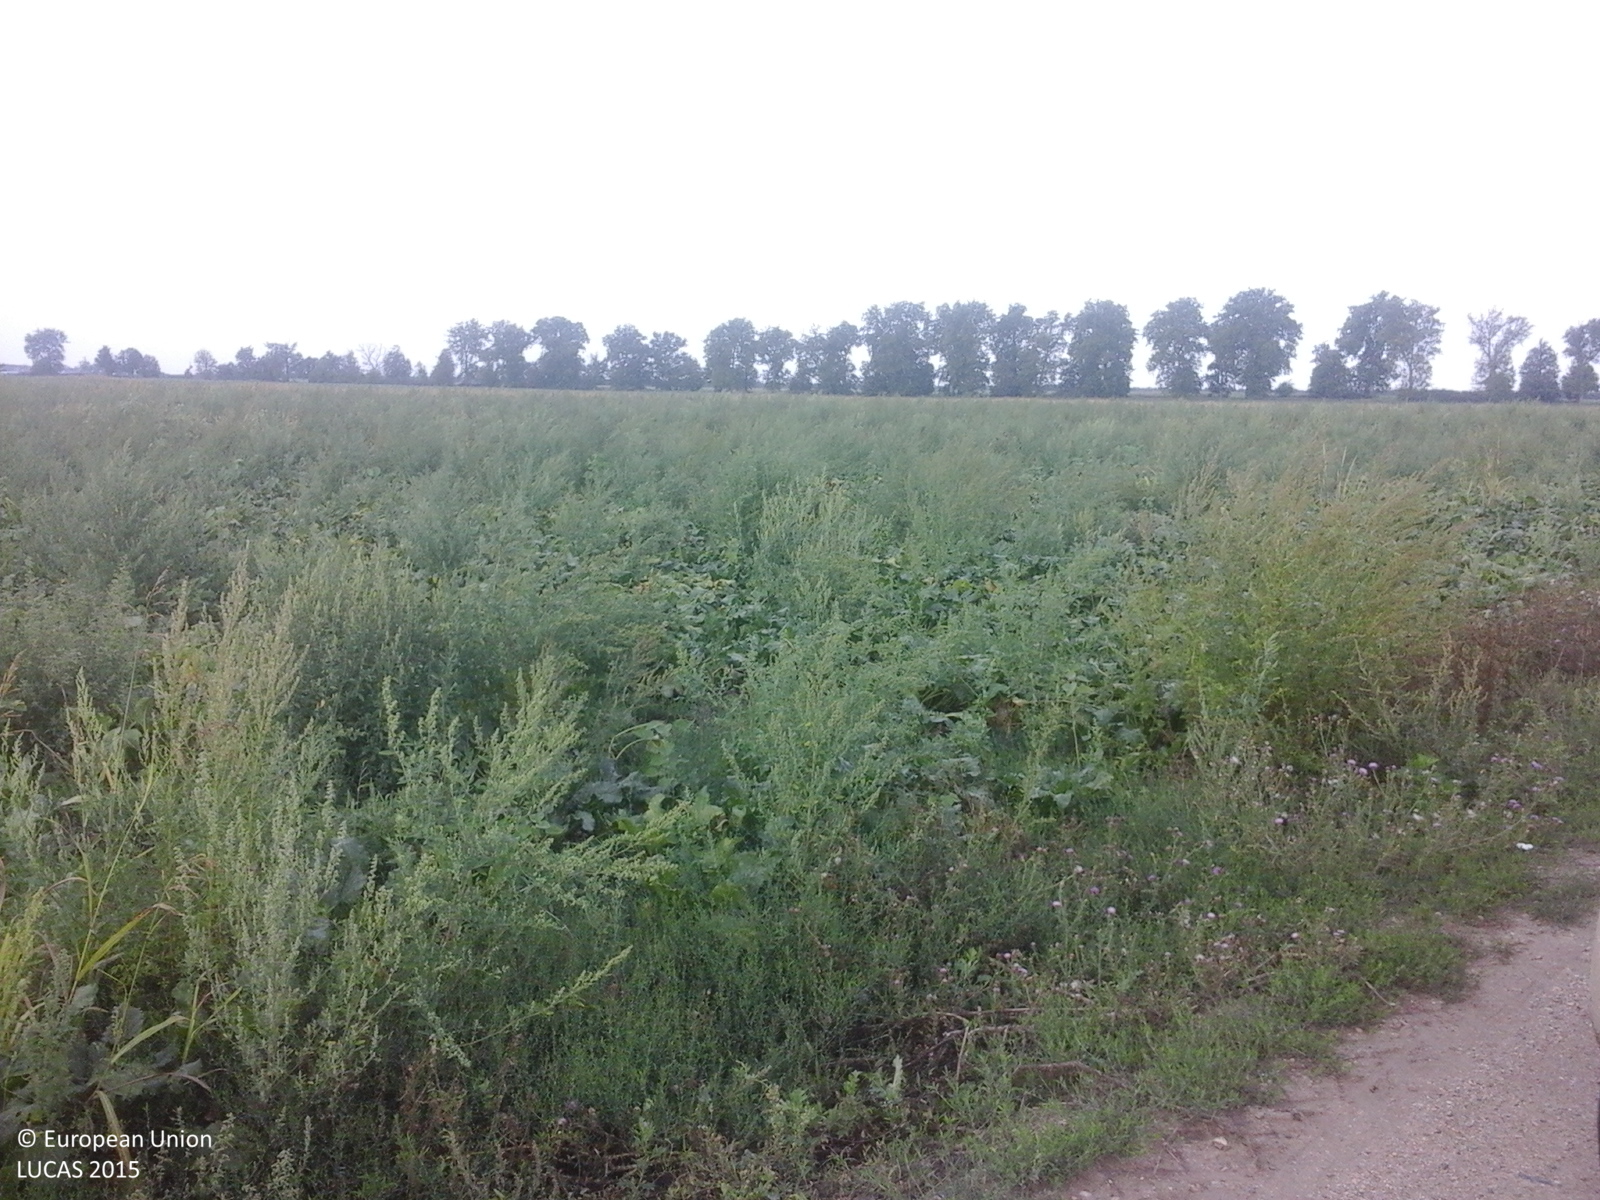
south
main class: Cropland
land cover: Sunflower
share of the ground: > 75 %
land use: Agriculture (excluding fallow land and kitchen gardens)
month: August
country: RO
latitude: 46.2886
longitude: 21.3667
